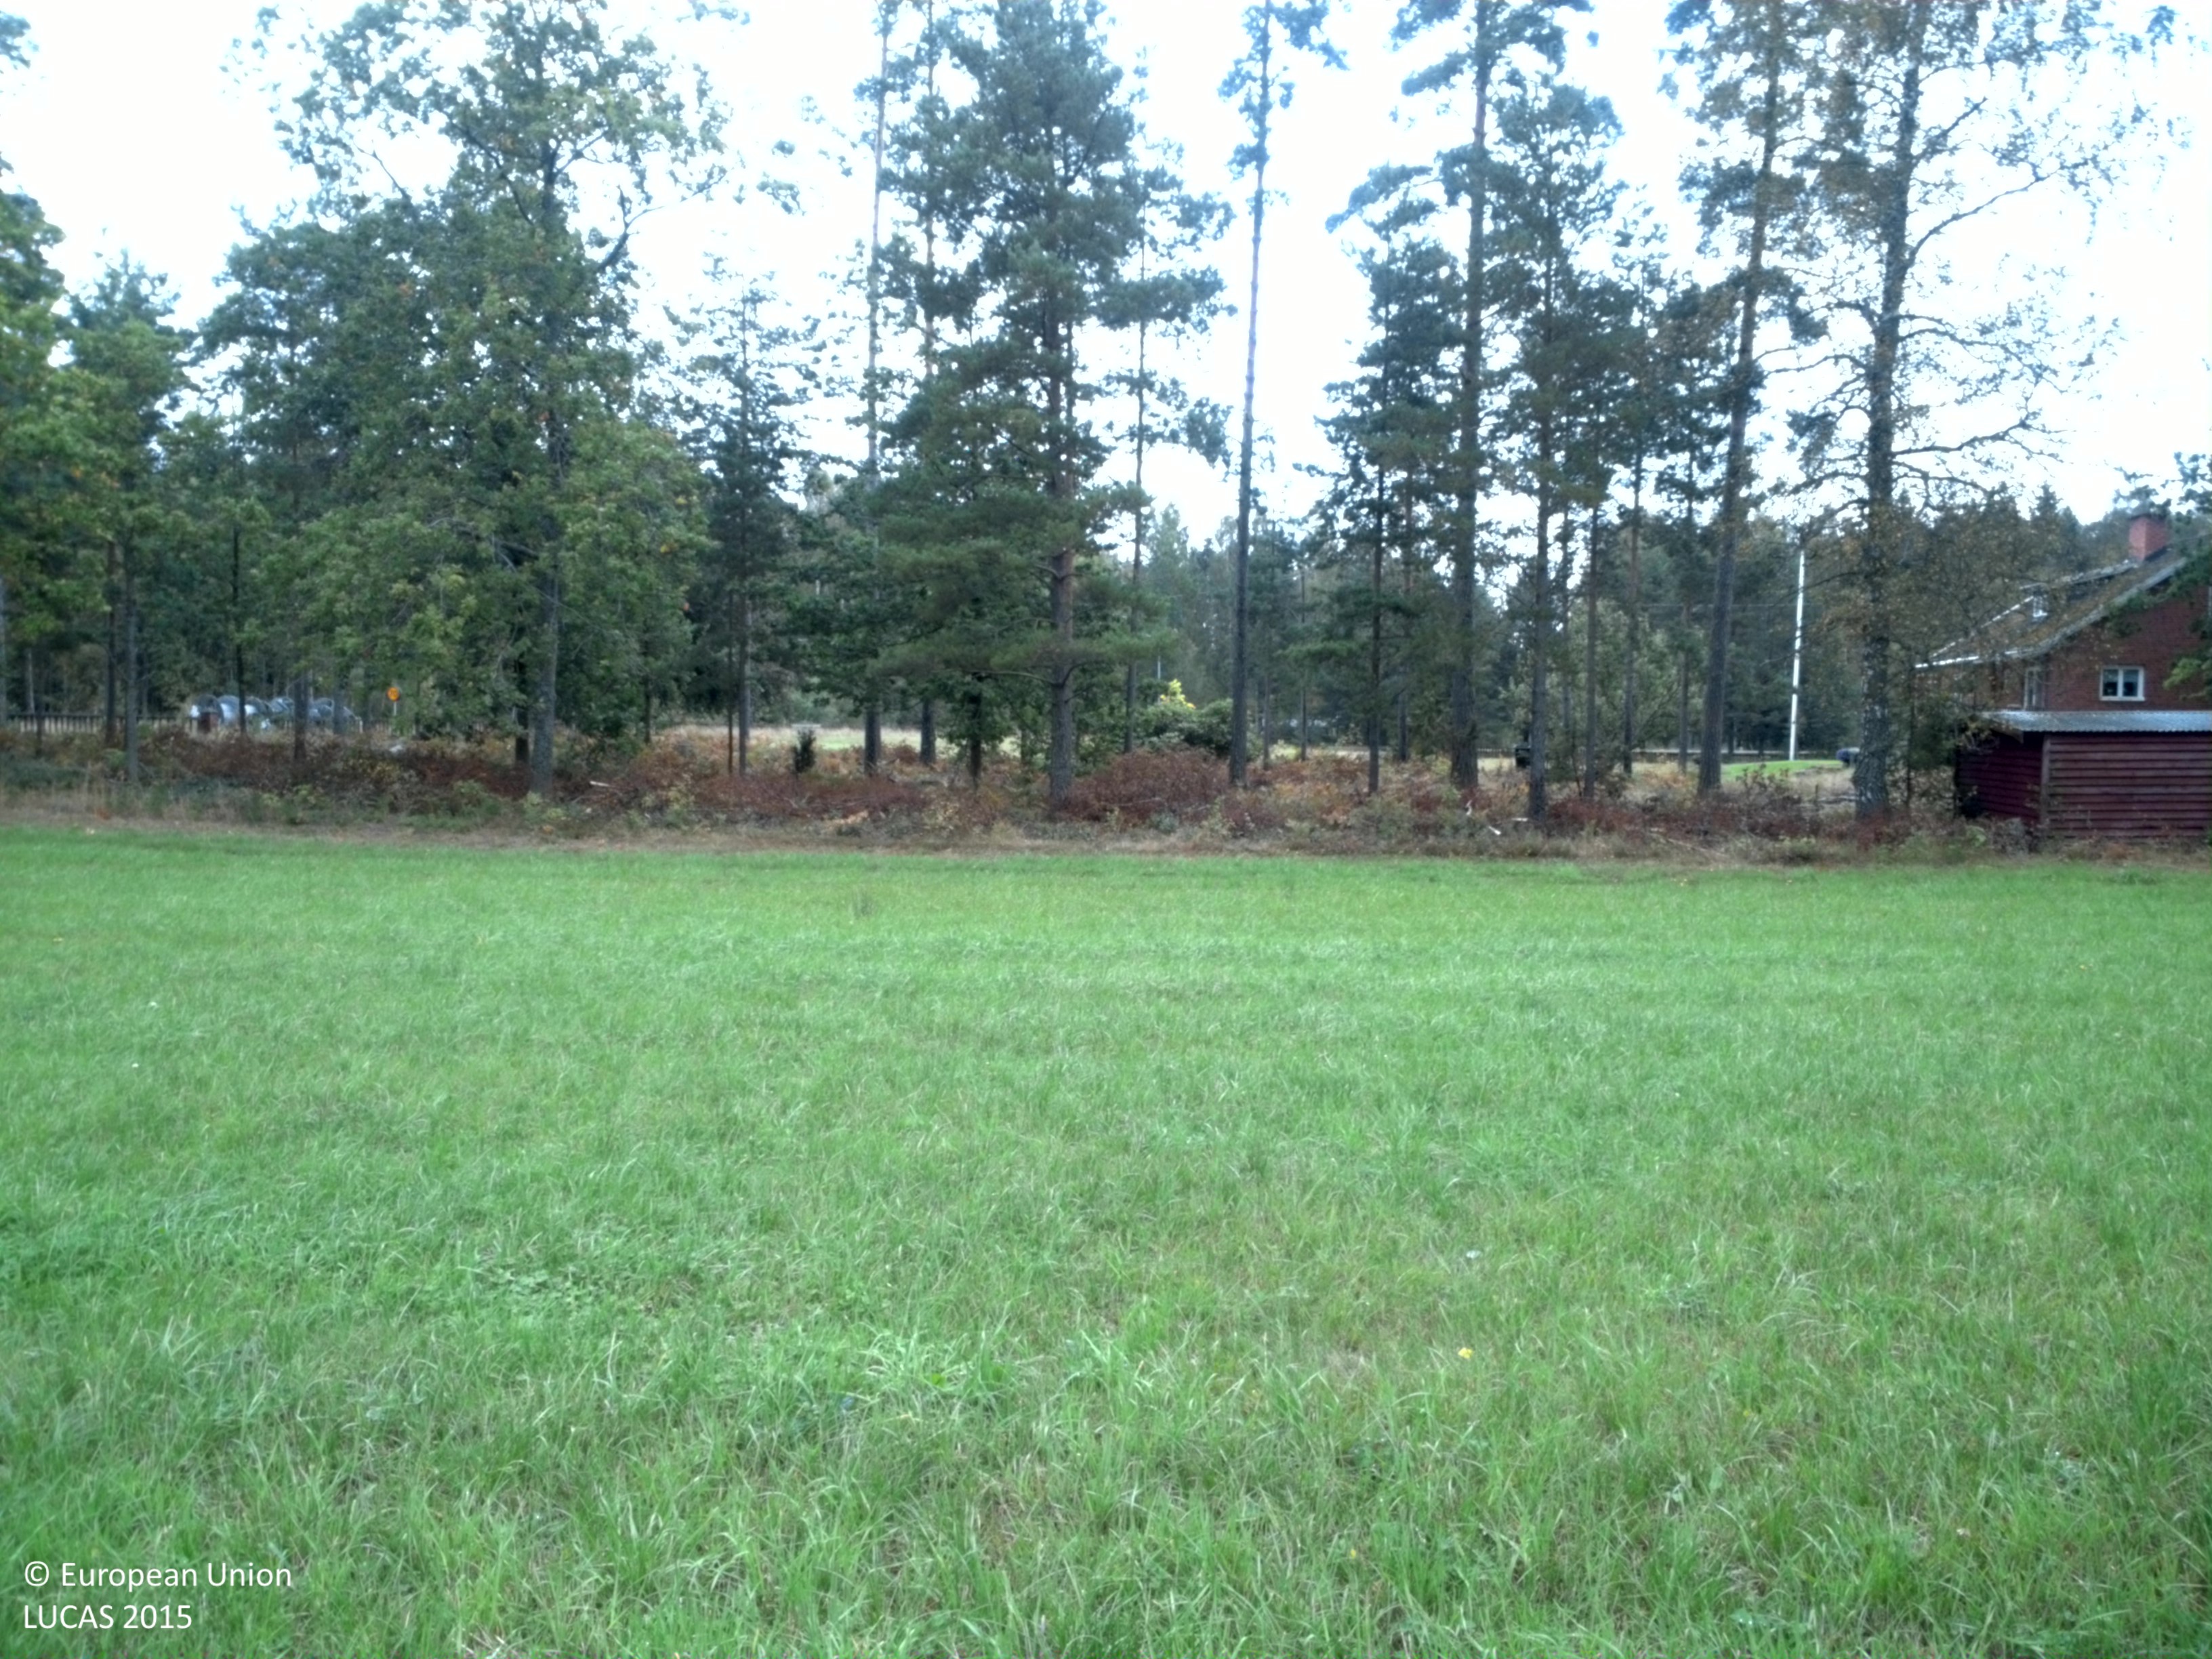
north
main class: Cropland
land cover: Temporary grasslands
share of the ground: > 75 %
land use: Agriculture (excluding fallow land and kitchen gardens)
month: September
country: SE
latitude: 59.0042
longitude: 14.0837
